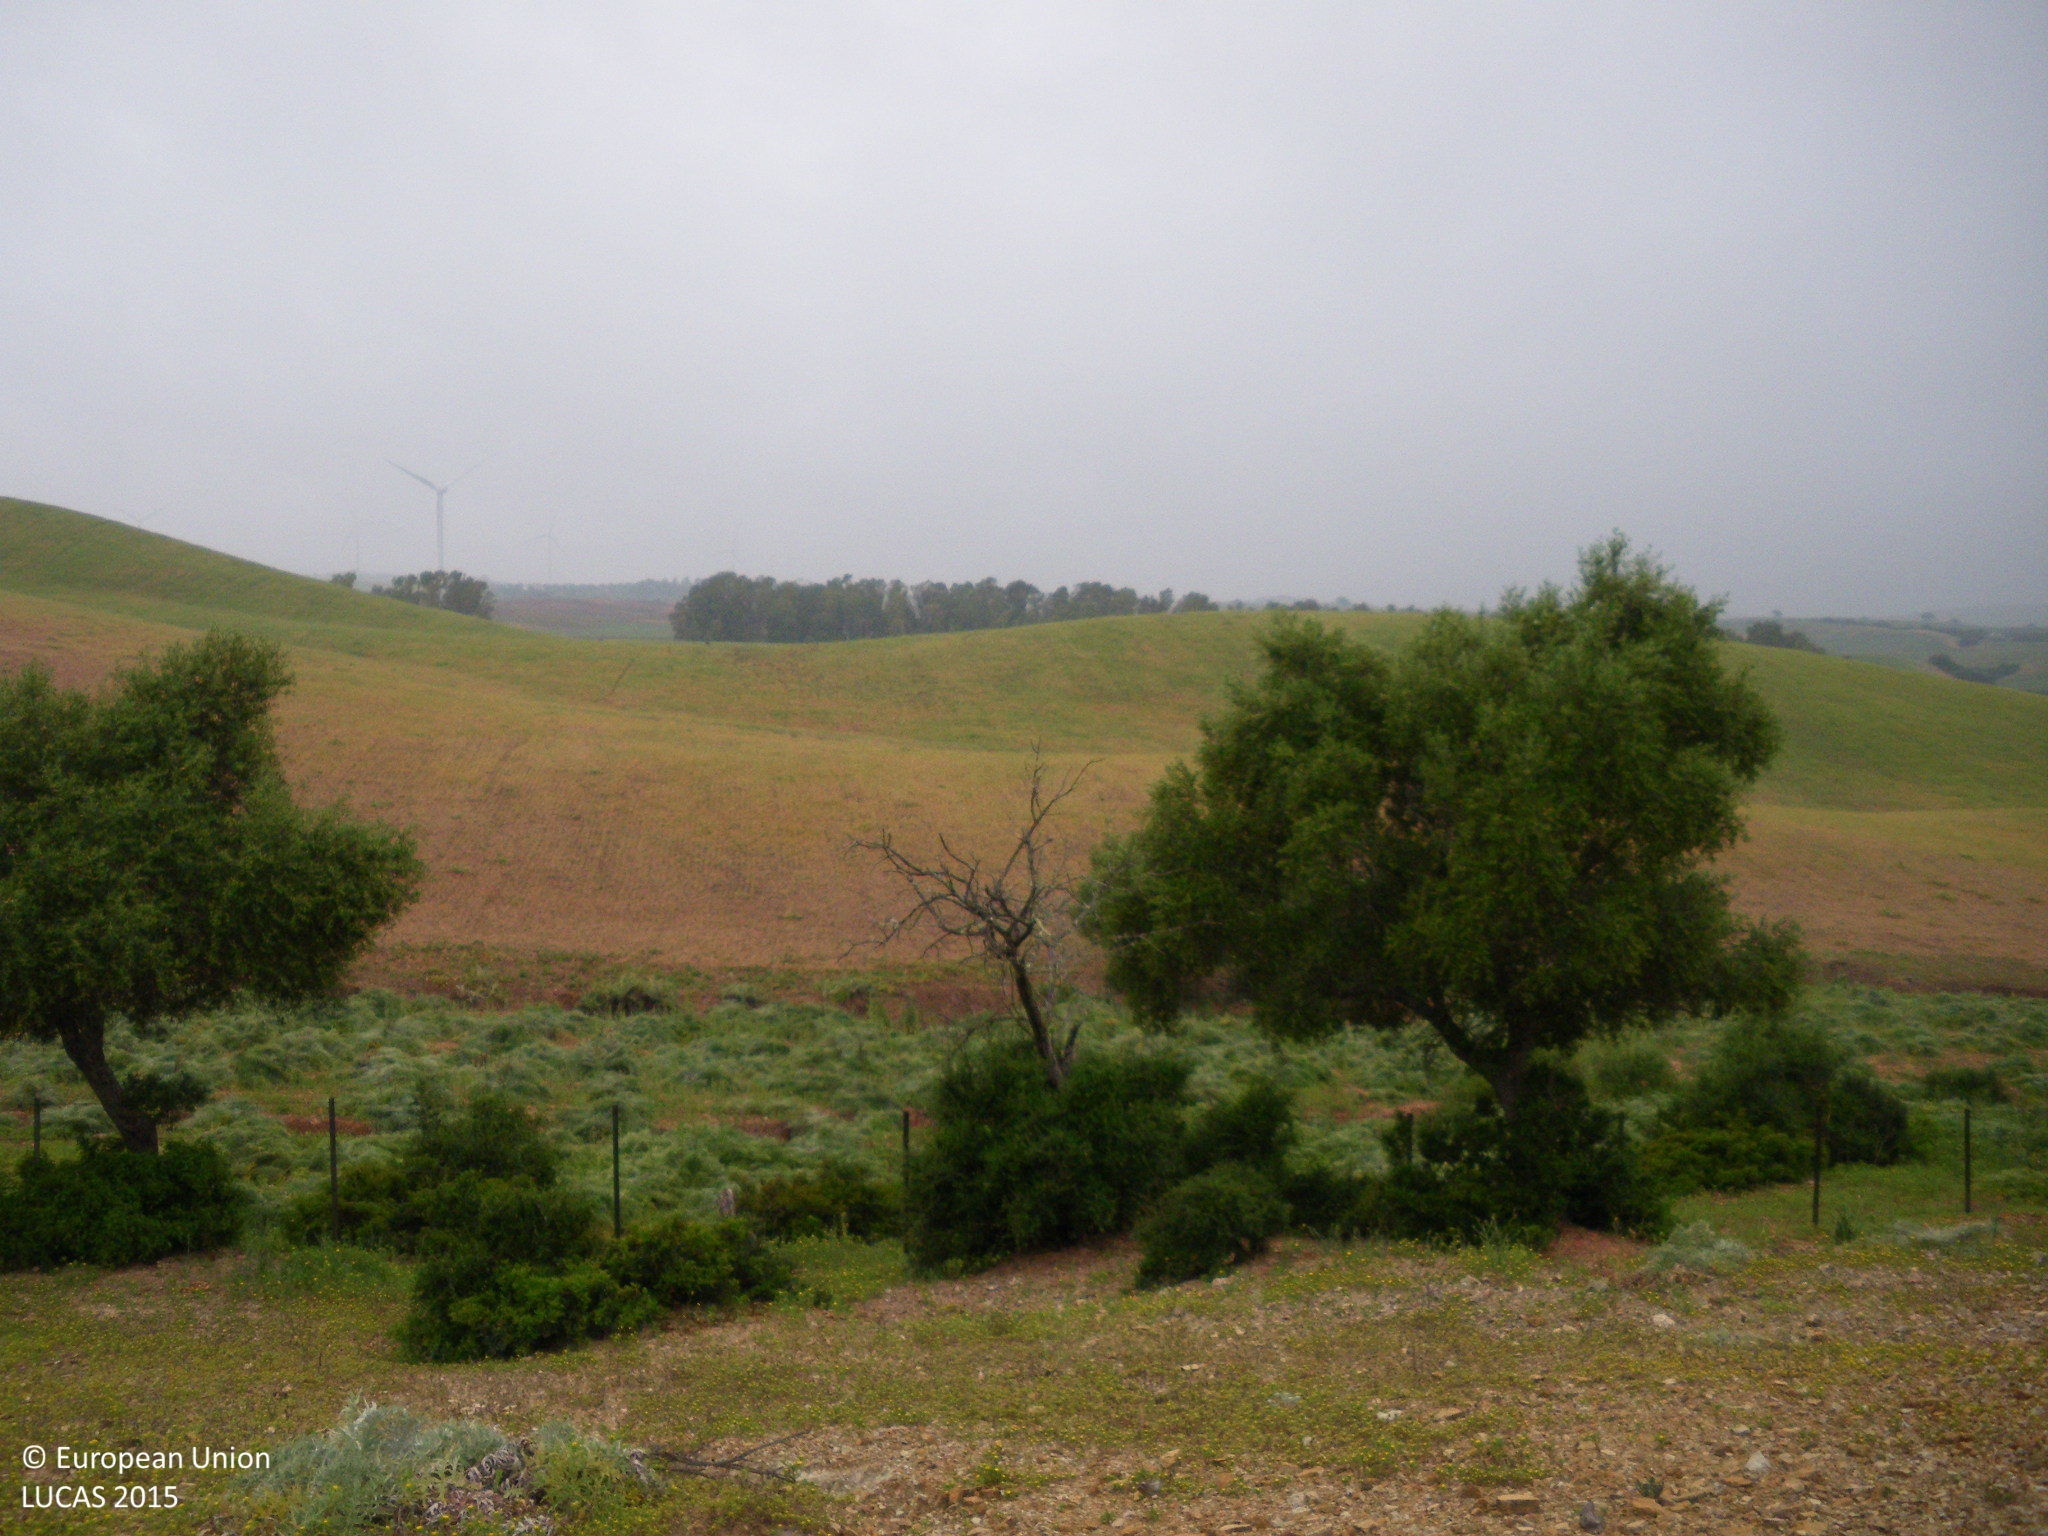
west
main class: Woodland
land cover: Broadleaved woodland
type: broadleaved evergreen forest
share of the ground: 10 - 25 %
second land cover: Grassland without tree/shrub cover
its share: 25 - 50 %
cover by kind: unconsolidated bare surface 50 %, herbaceous plants 30 %, broadleaved forest trees 15 %, shrubs 5 %
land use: Forestry
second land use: Agriculture (excluding fallow land and kitchen gardens)
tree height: > 5 m
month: April
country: ES
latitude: 36.5261
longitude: -5.9202
